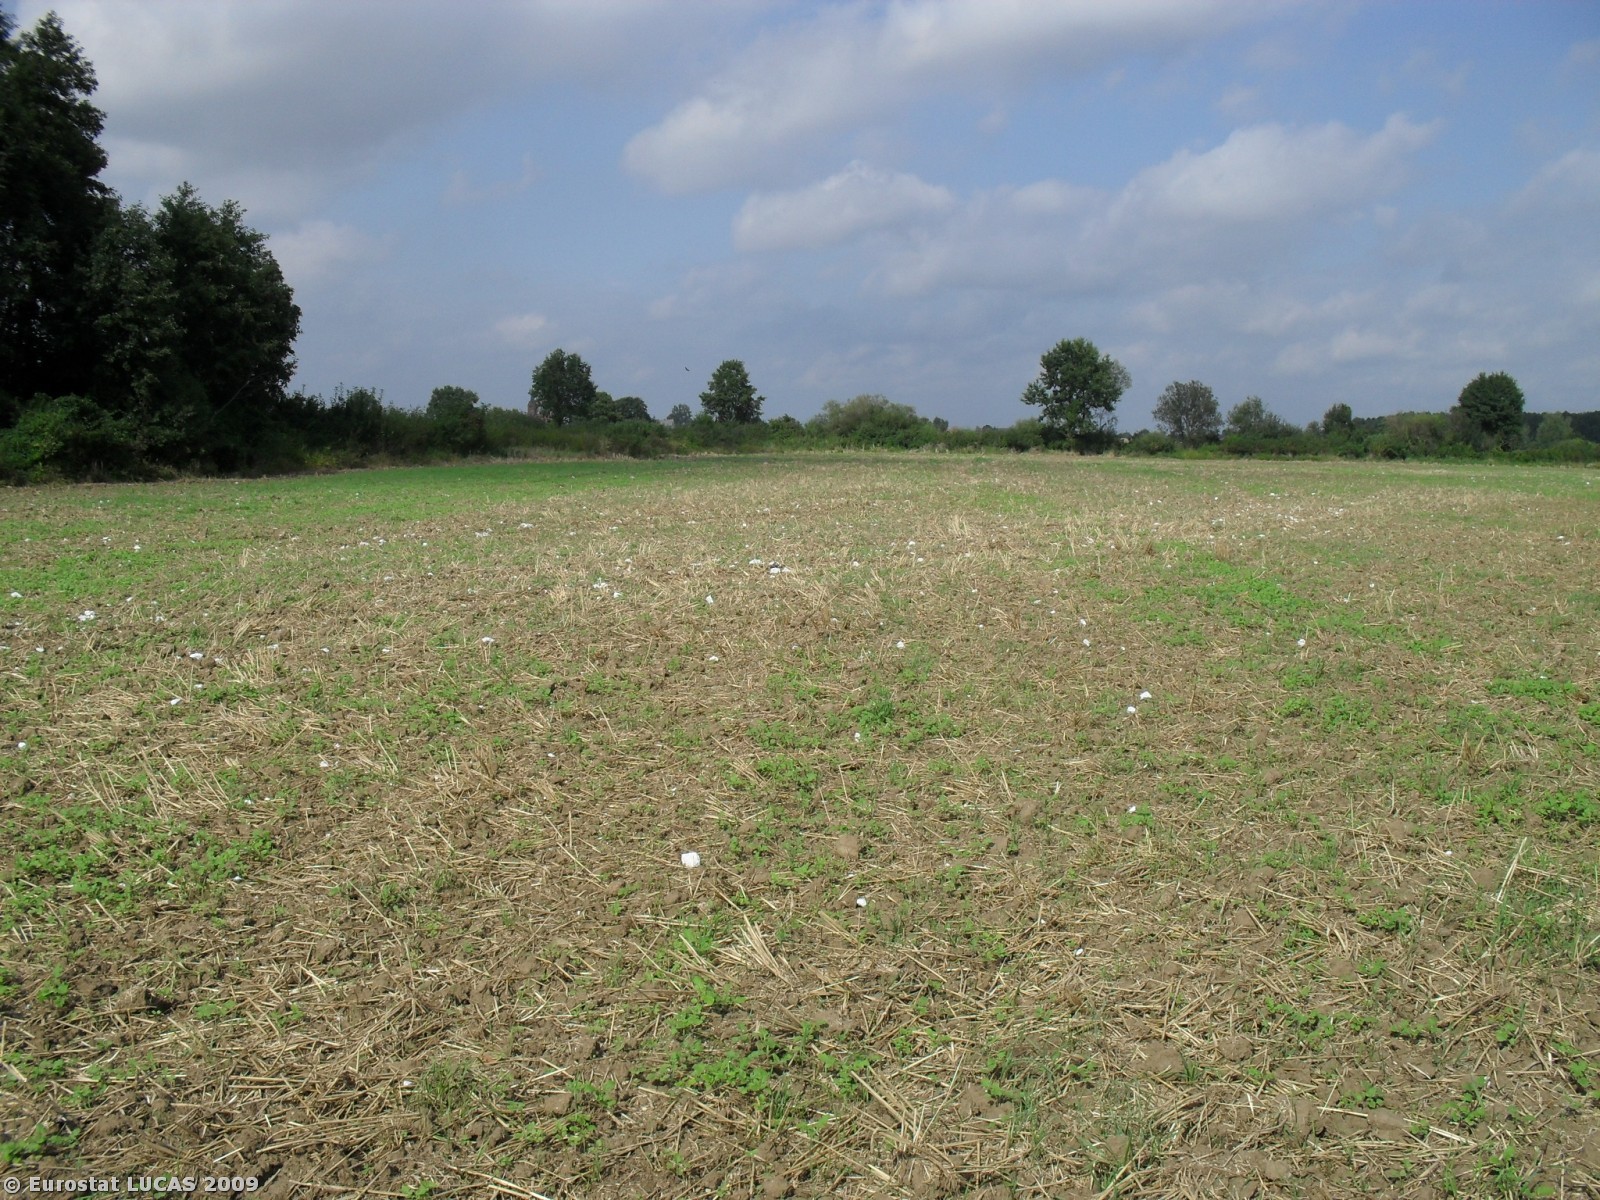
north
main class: Cropland
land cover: Common wheat
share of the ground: < 10 %
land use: Agriculture (excluding fallow land and kitchen gardens)
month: September
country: PL
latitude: 50.8923
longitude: 17.2477
